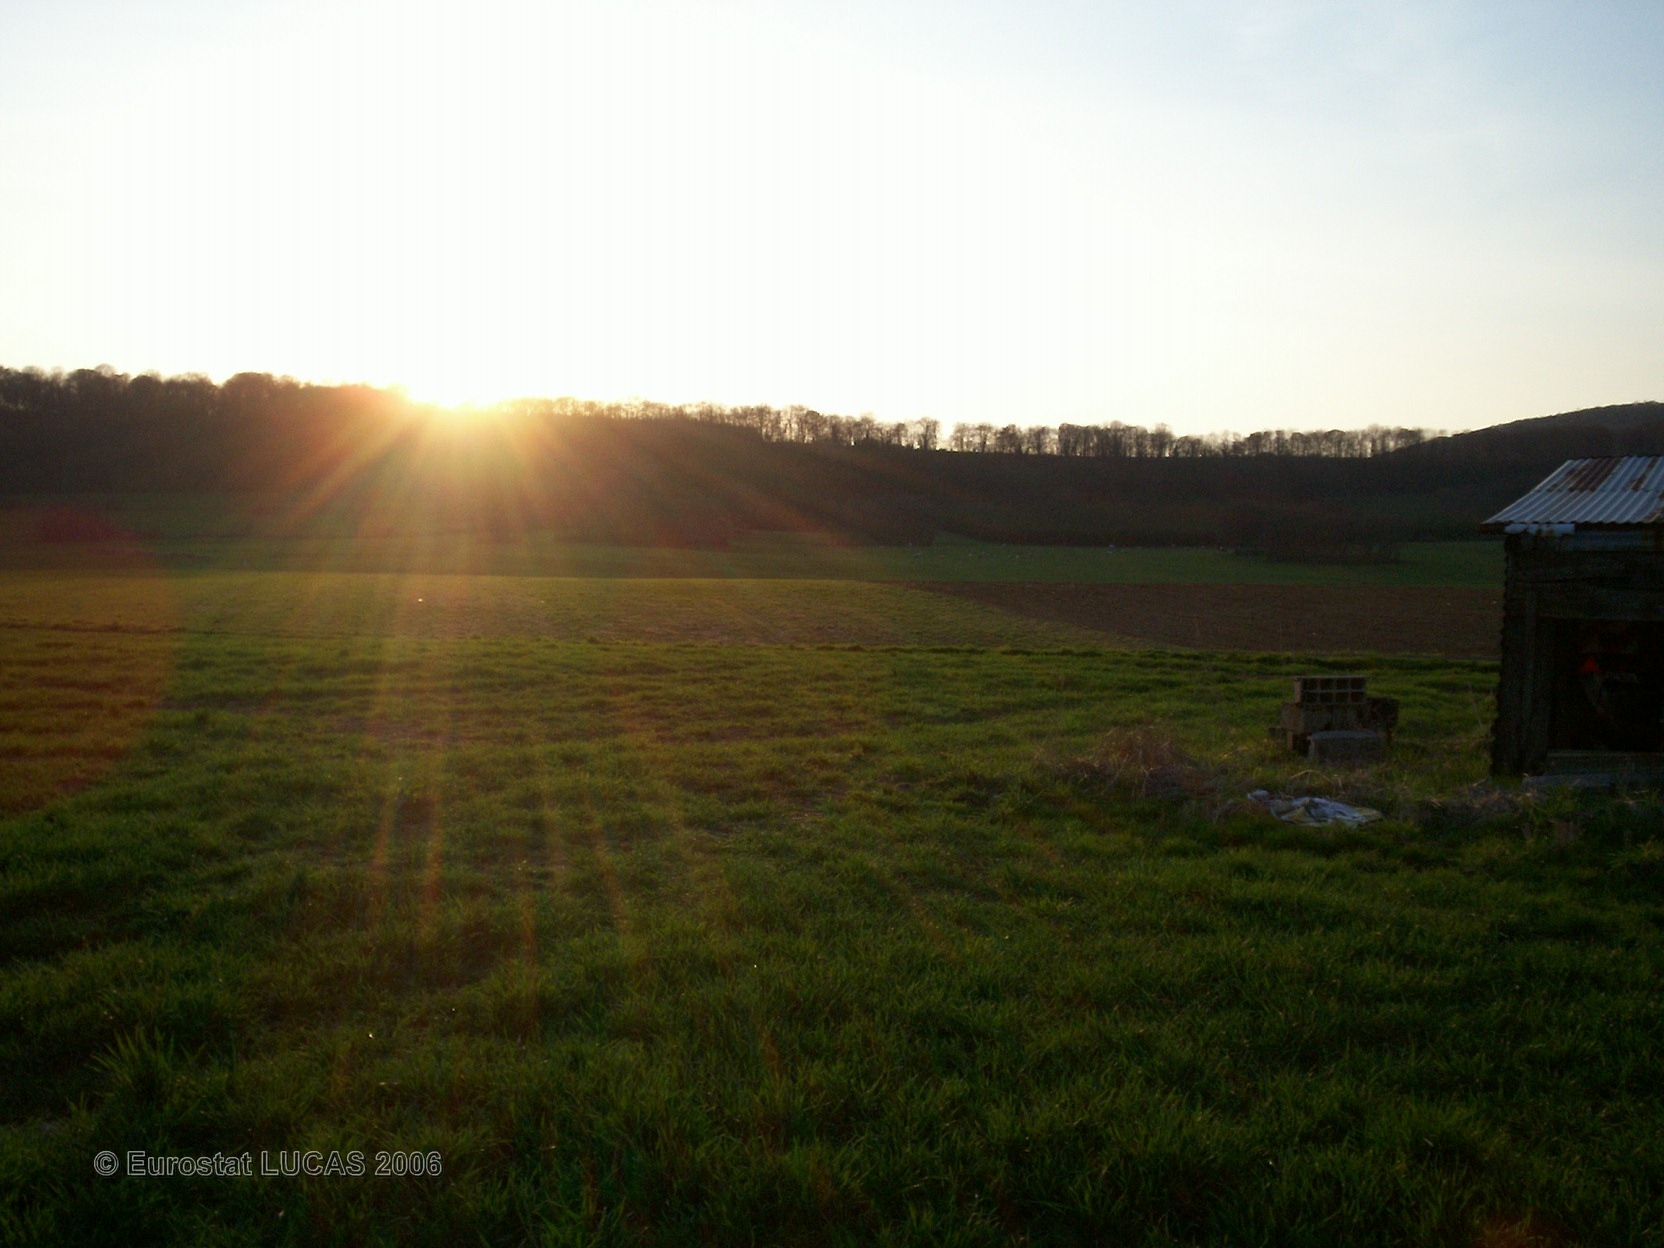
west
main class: Cropland
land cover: Maize
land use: Agriculture (excluding fallow land and kitchen gardens)
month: May
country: FR
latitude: 47.3425
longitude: 6.6003
